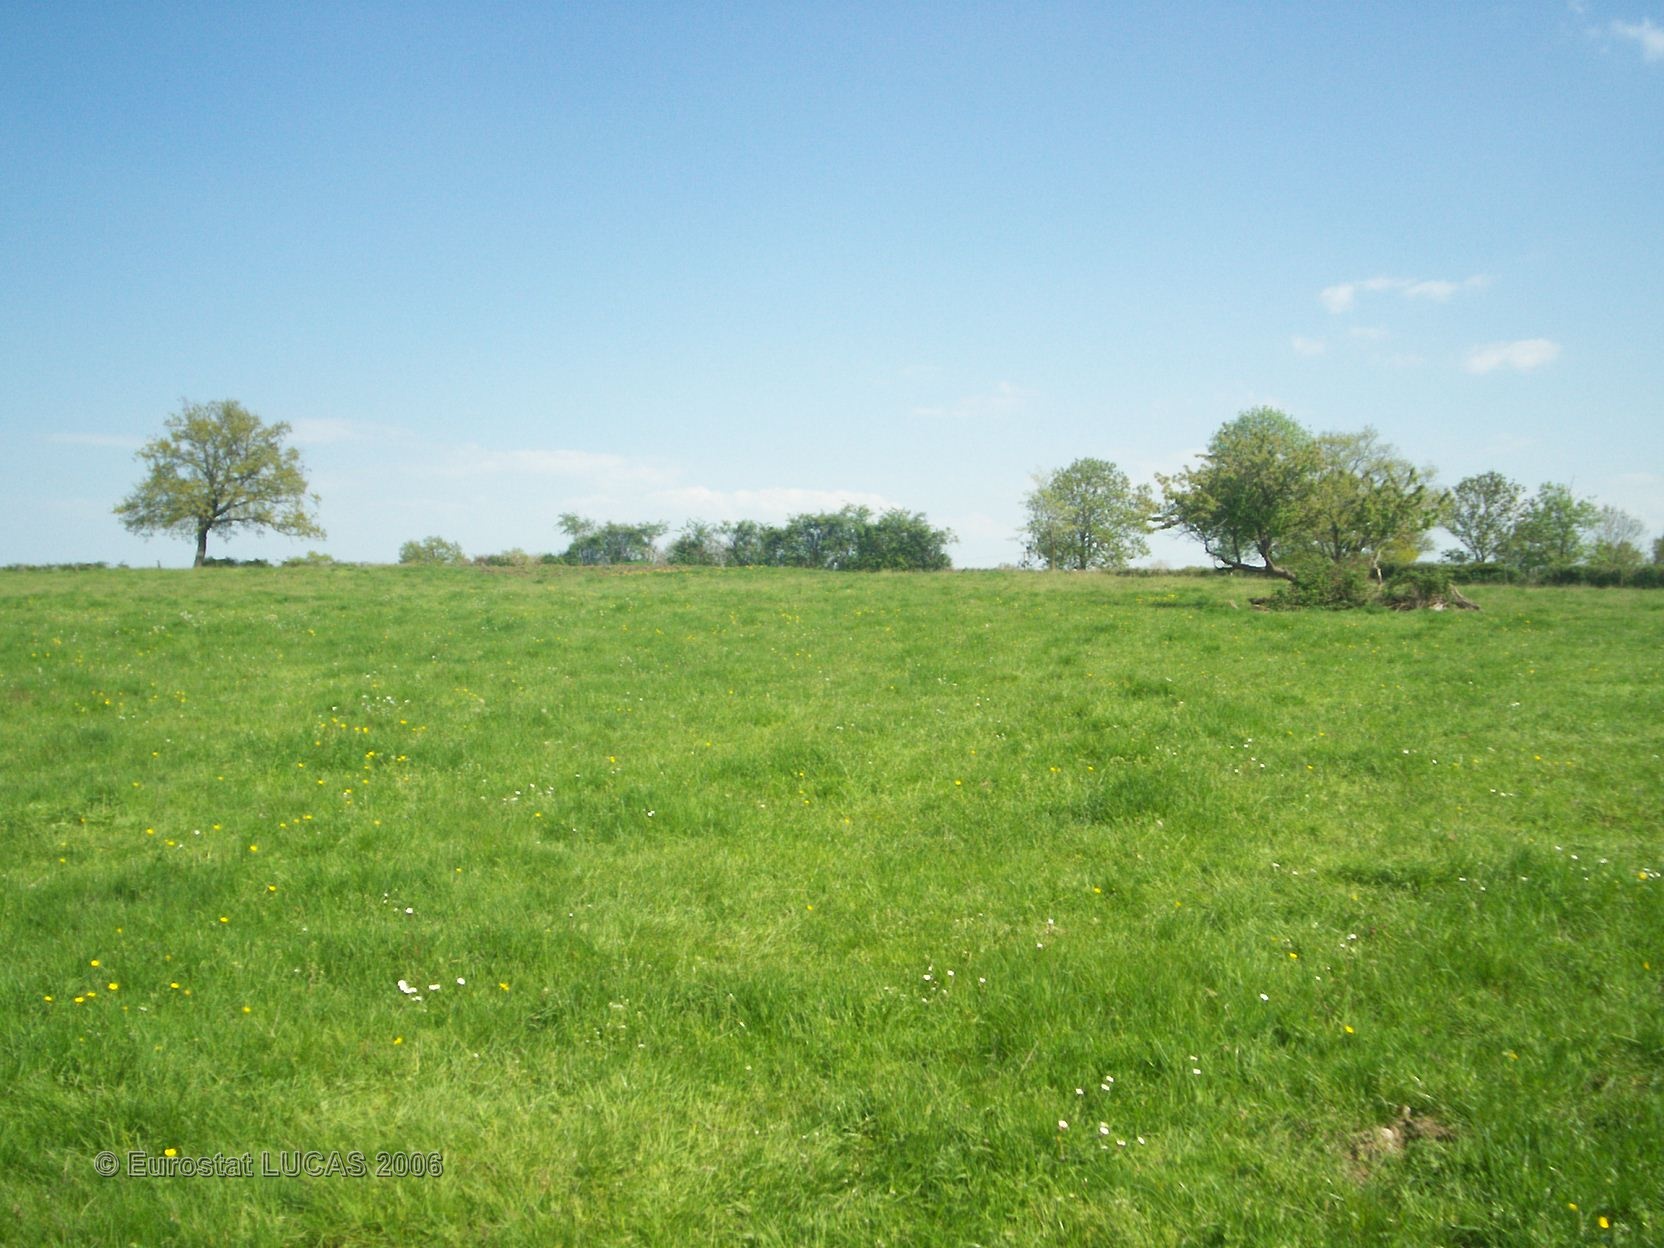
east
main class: Grassland
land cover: Grassland without tree/shrub cover
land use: Agriculture (excluding fallow land and kitchen gardens)
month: May
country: FR
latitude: 46.3288
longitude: 3.1266
